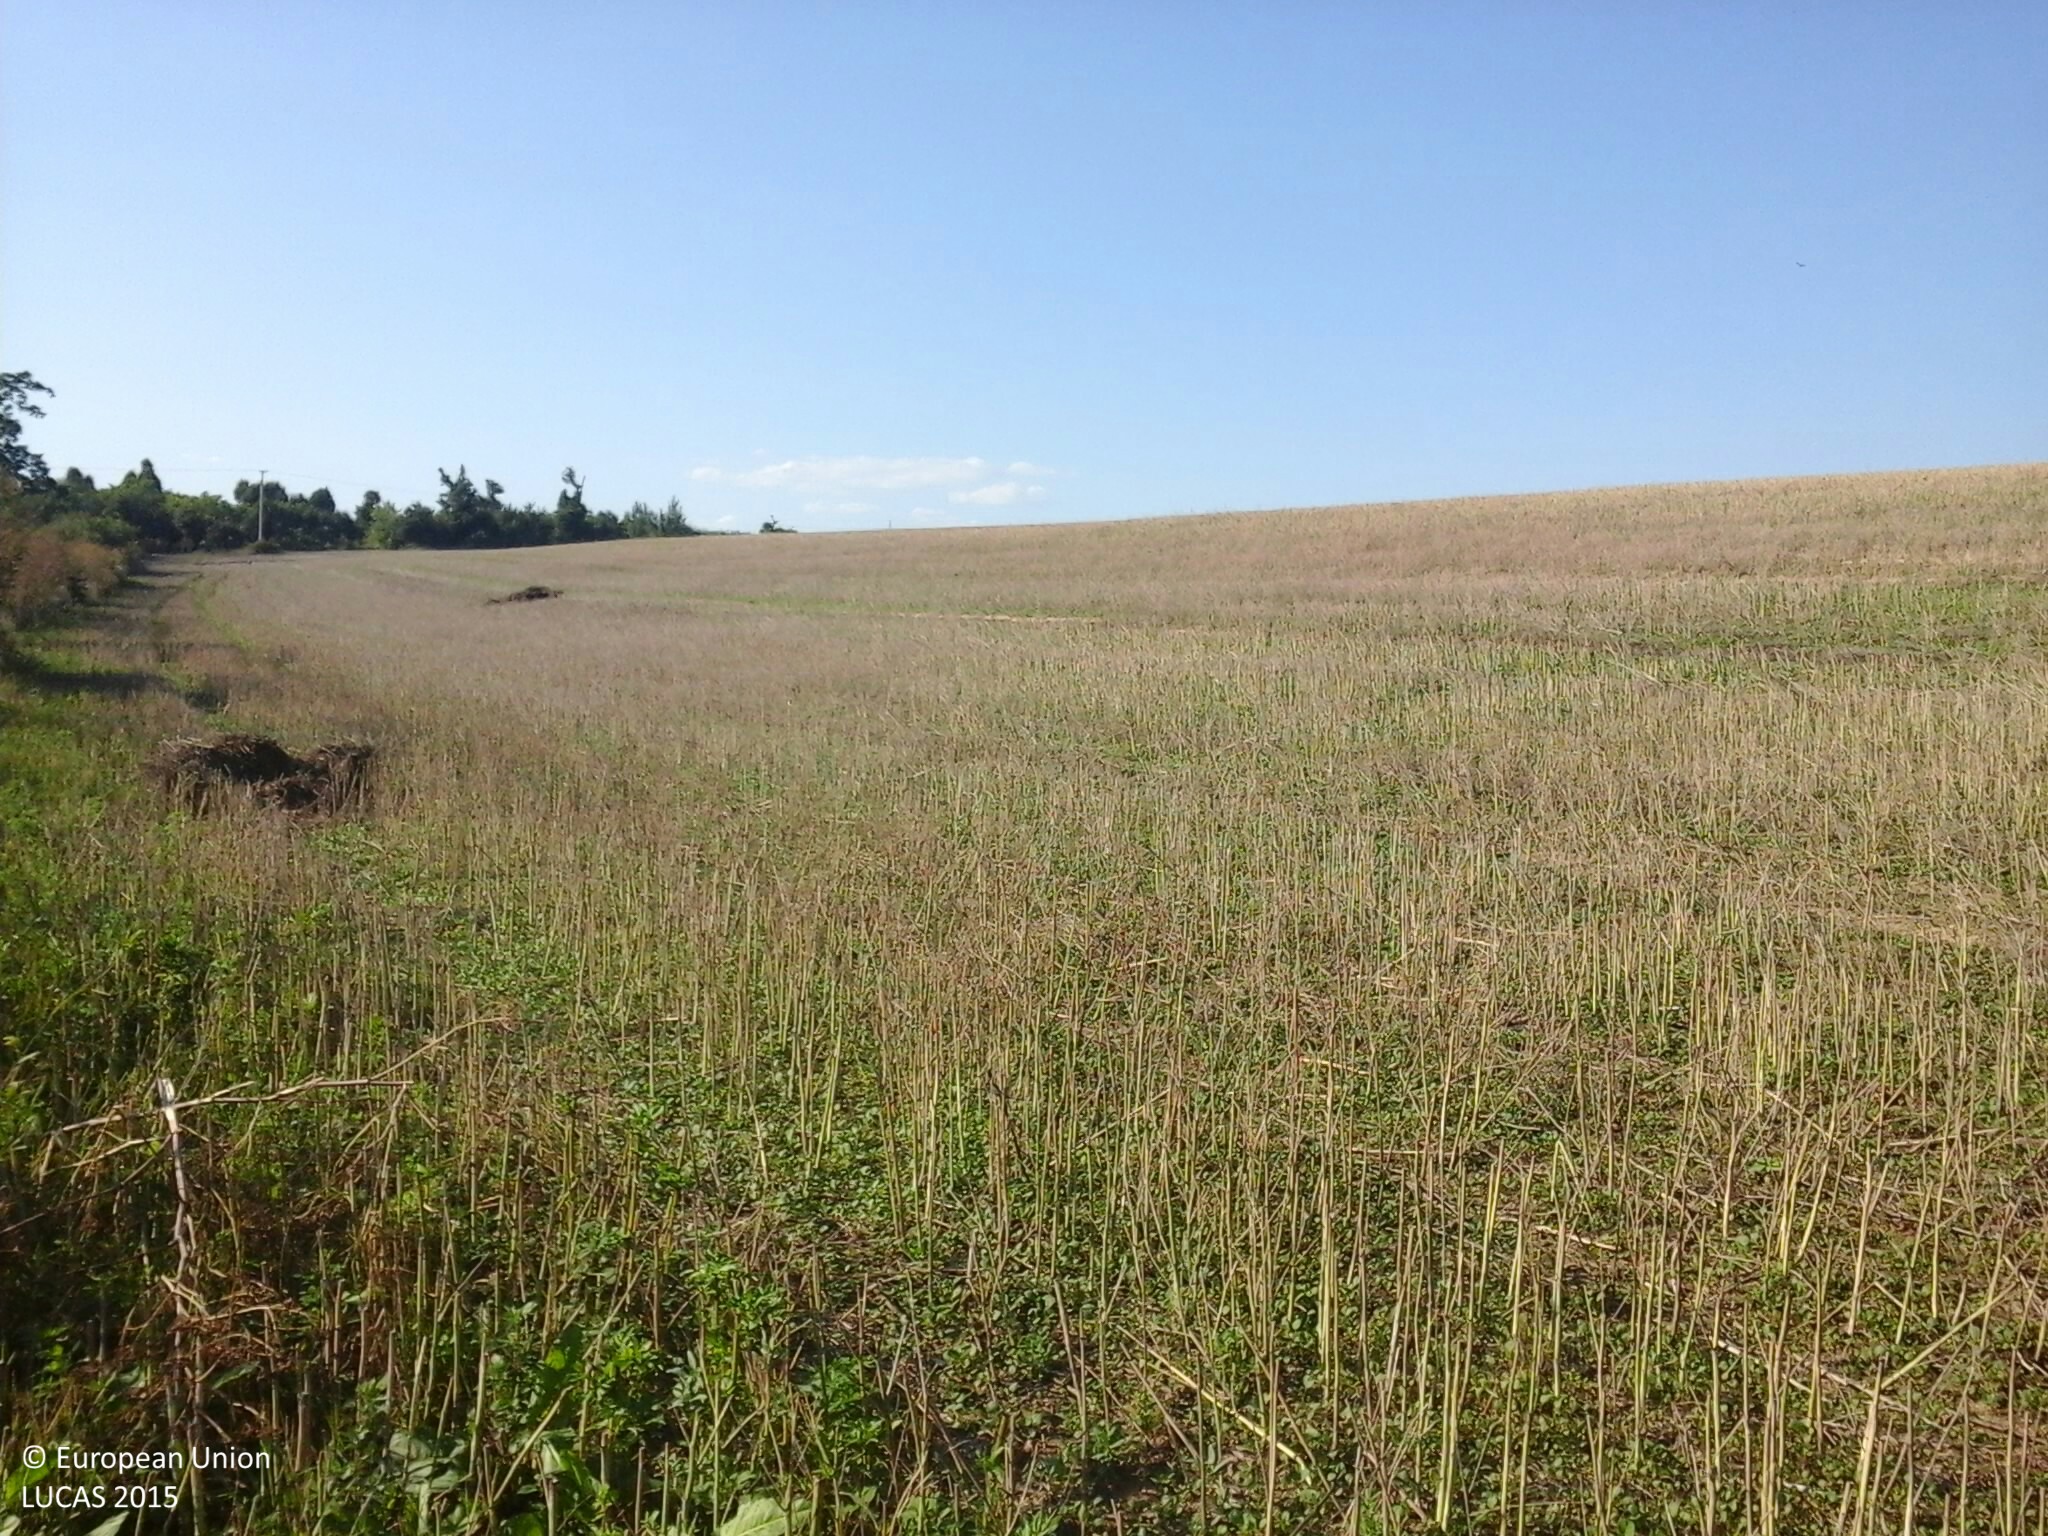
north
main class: Shrubland
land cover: Shrubland with sparse tree cover
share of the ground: > 75 %
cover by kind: shrubs 95 %, broadleaved forest trees 5 %
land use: Semi-natural and natural areas not in use
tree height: < 5 m
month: July
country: HU
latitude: 46.5965
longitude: 17.7208
